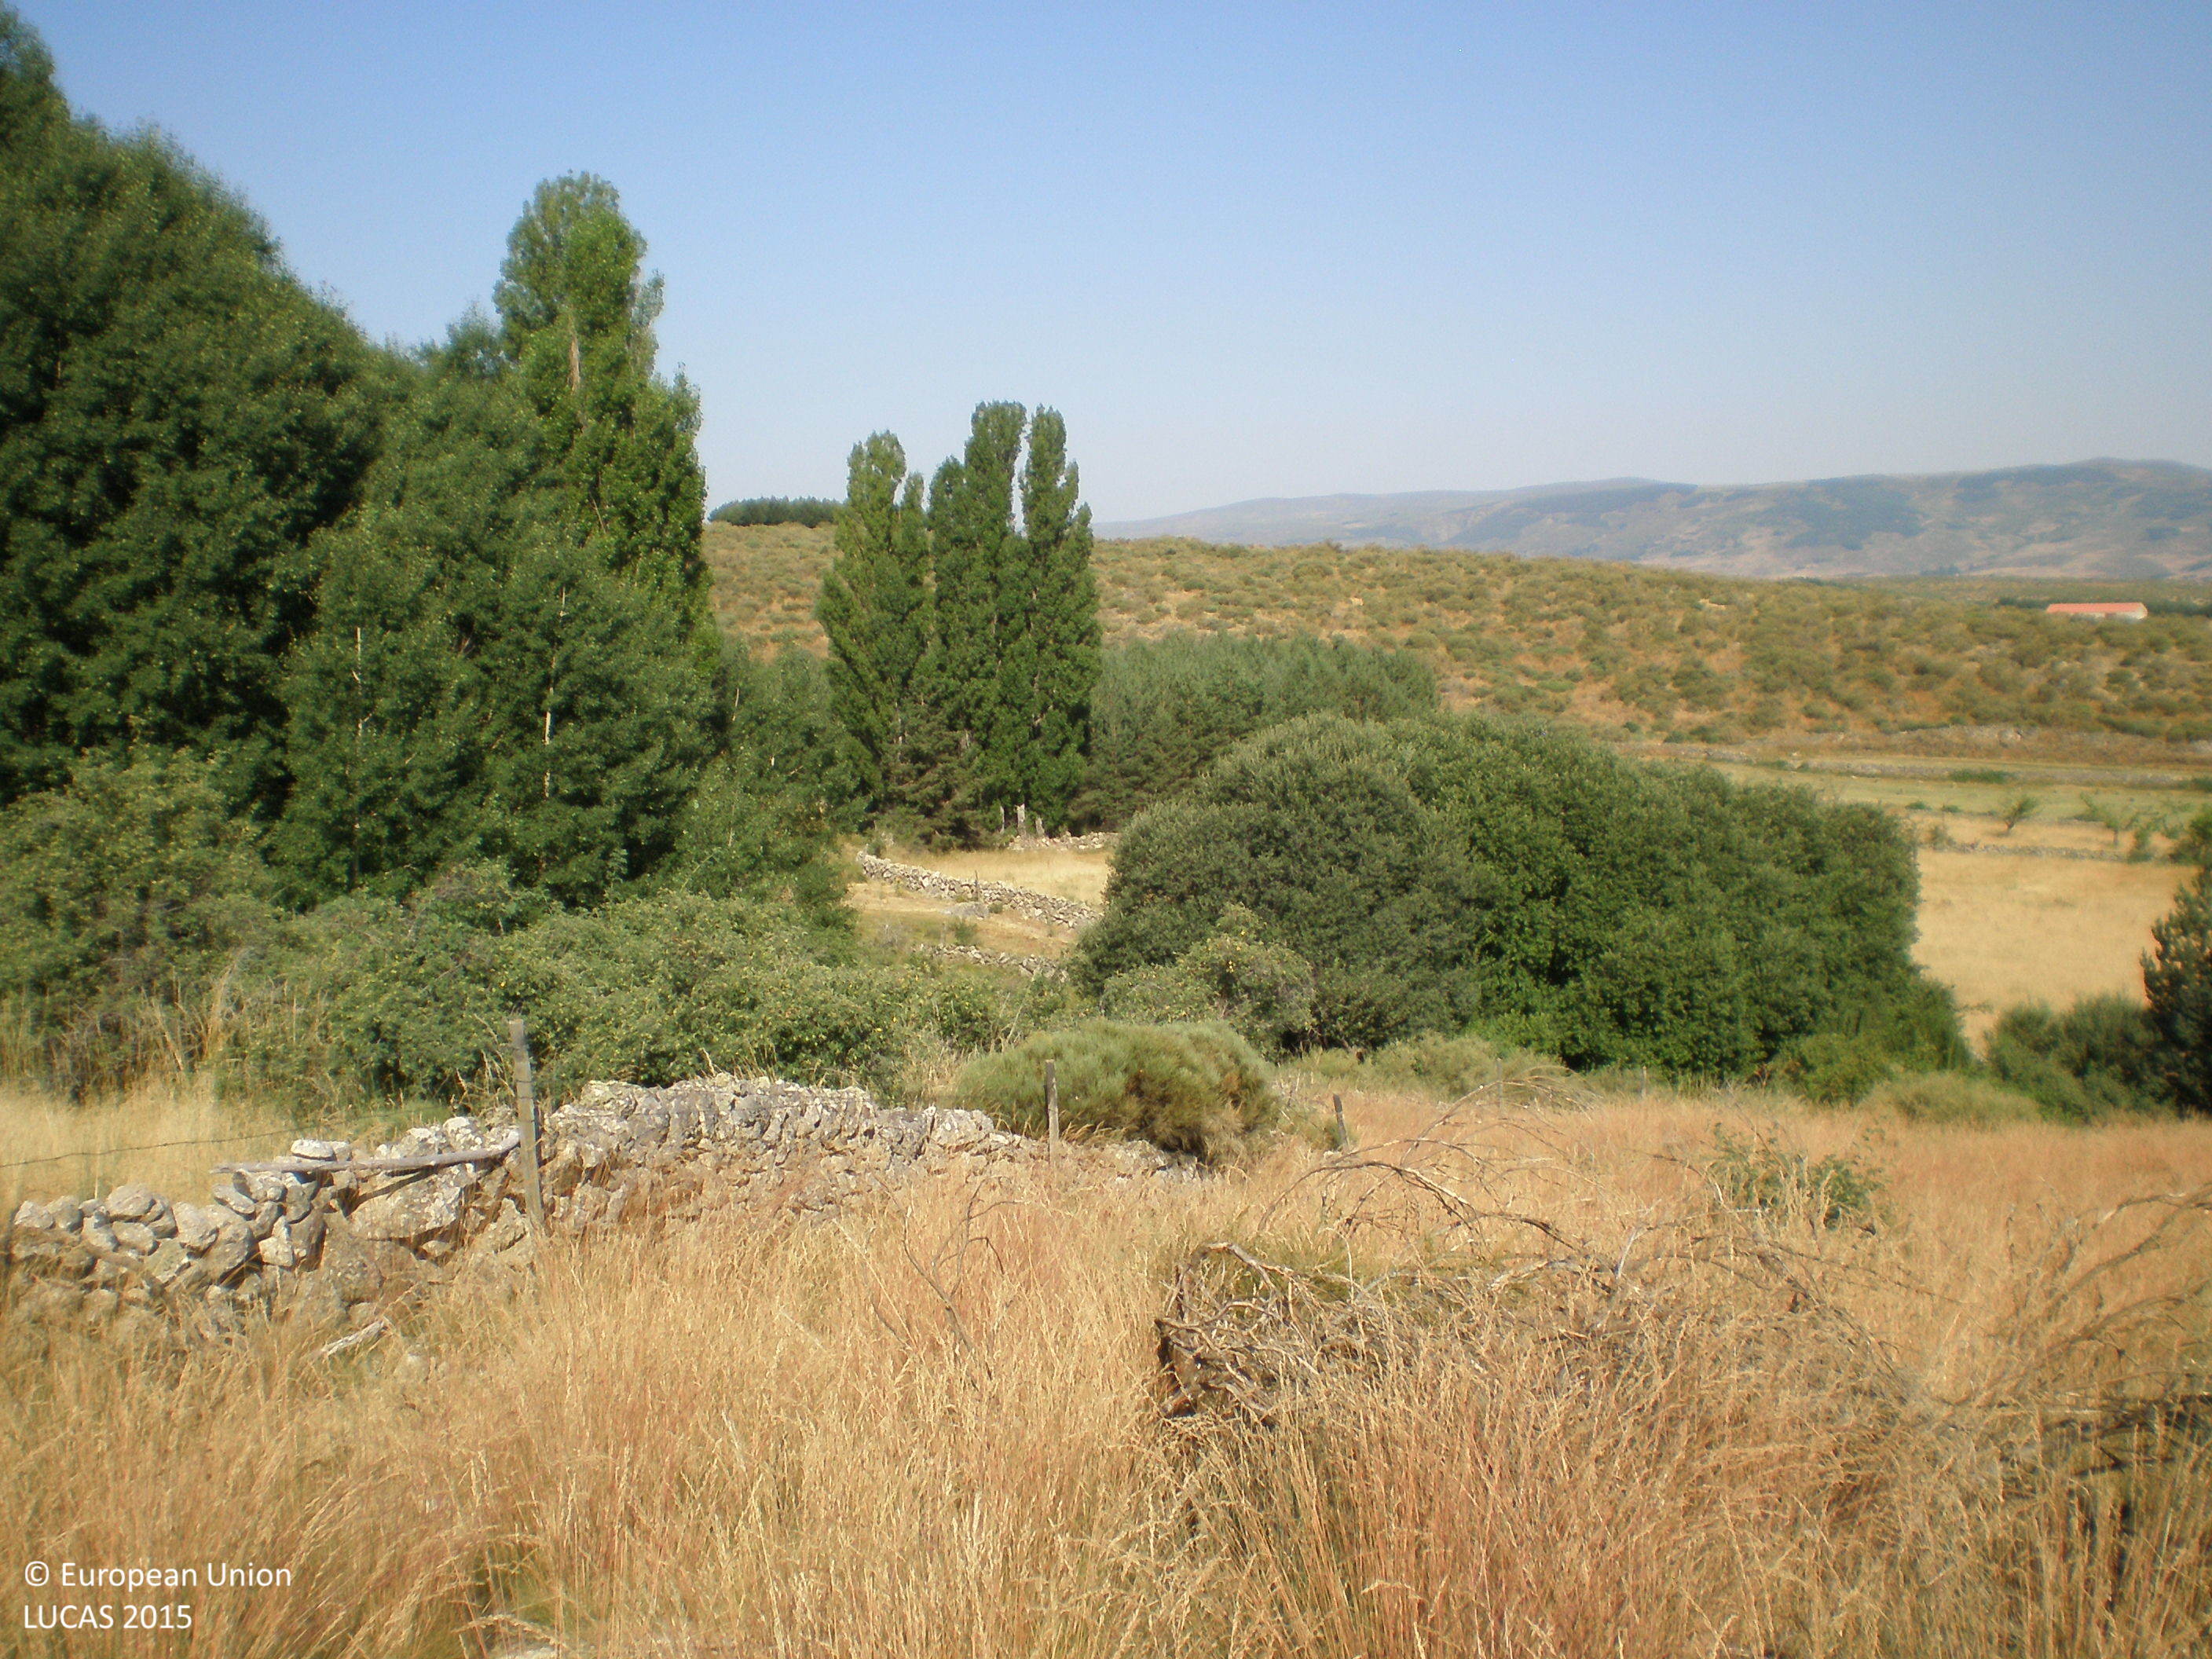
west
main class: Shrubland
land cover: Shrubland without tree cover
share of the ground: > 75 %
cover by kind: shrubs 80 %, herbaceous plants 20 %
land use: Abandoned areas
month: July
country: ES
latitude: 40.4158
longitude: -5.0846
